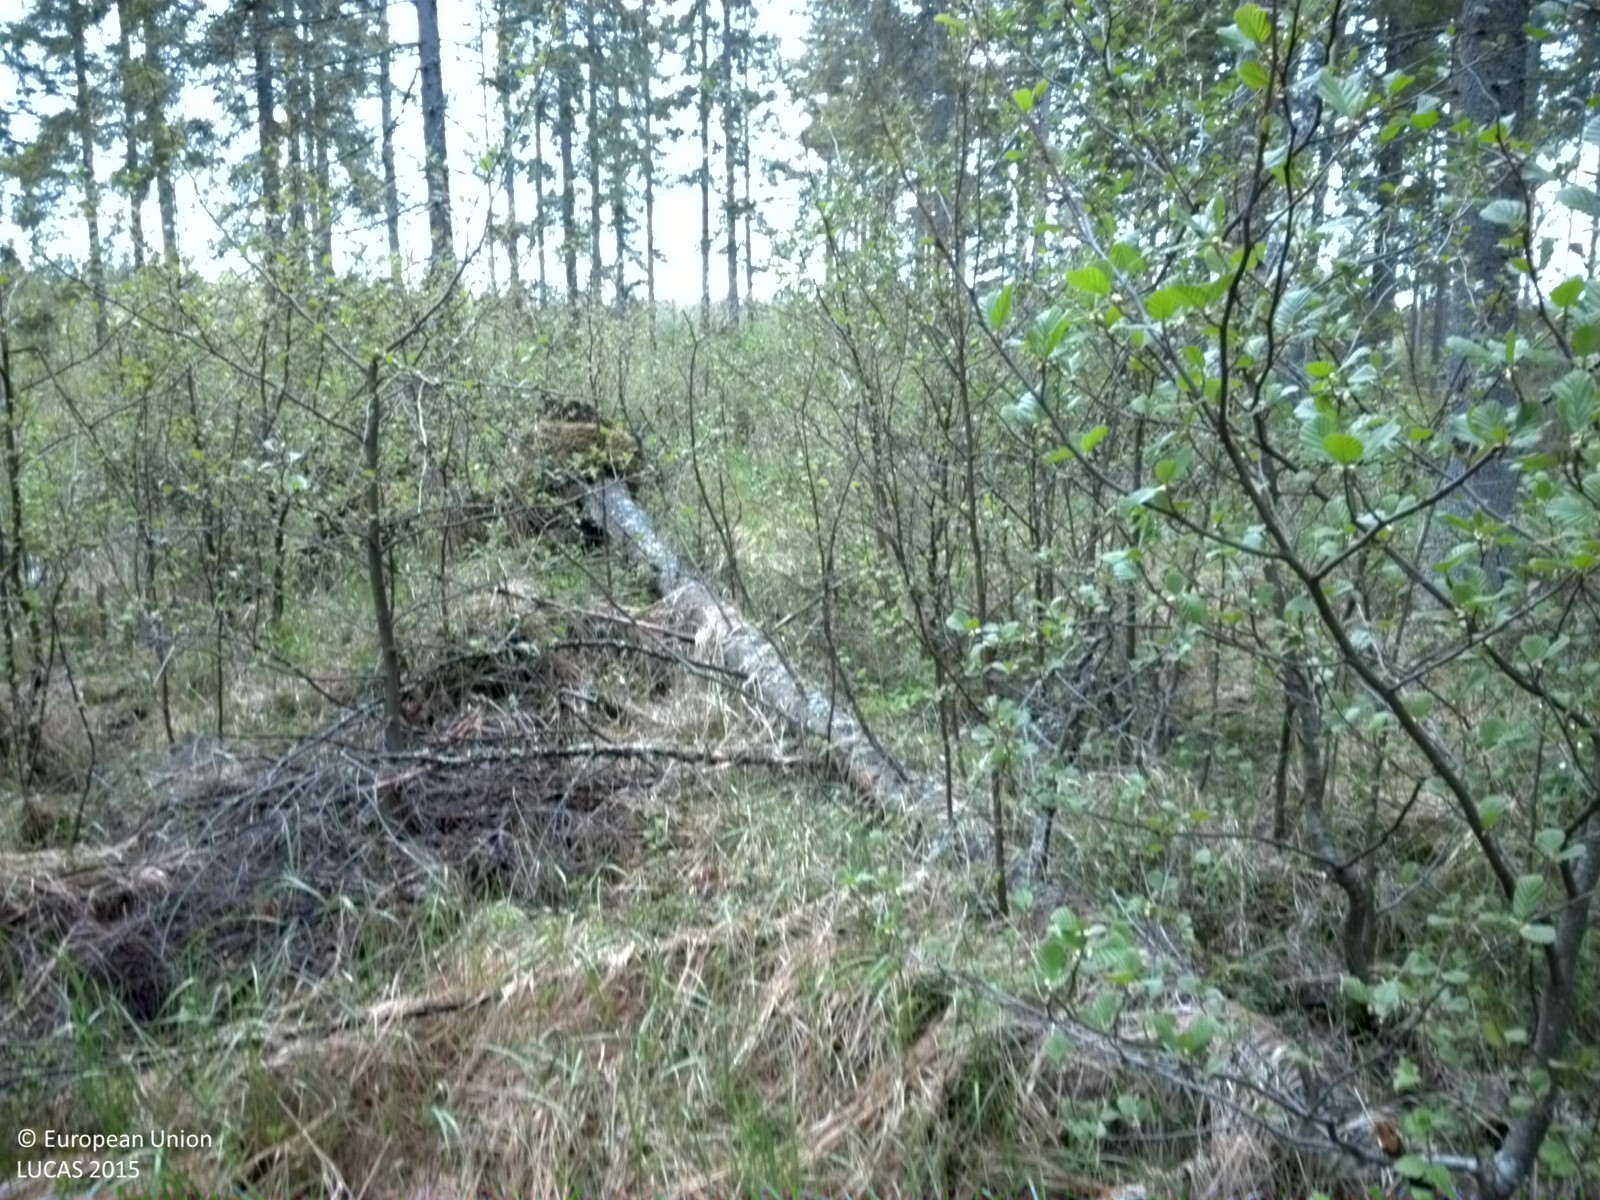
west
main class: Woodland
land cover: Spruce dominated coniferous woodland
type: boreal forest
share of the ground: > 75 %
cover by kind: coniferous forest trees 75 %, herbaceous plants 15 %, broadleaved forest trees 5 %
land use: Forestry
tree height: > 5 m
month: May
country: SE
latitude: 60.2255
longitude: 17.9916
